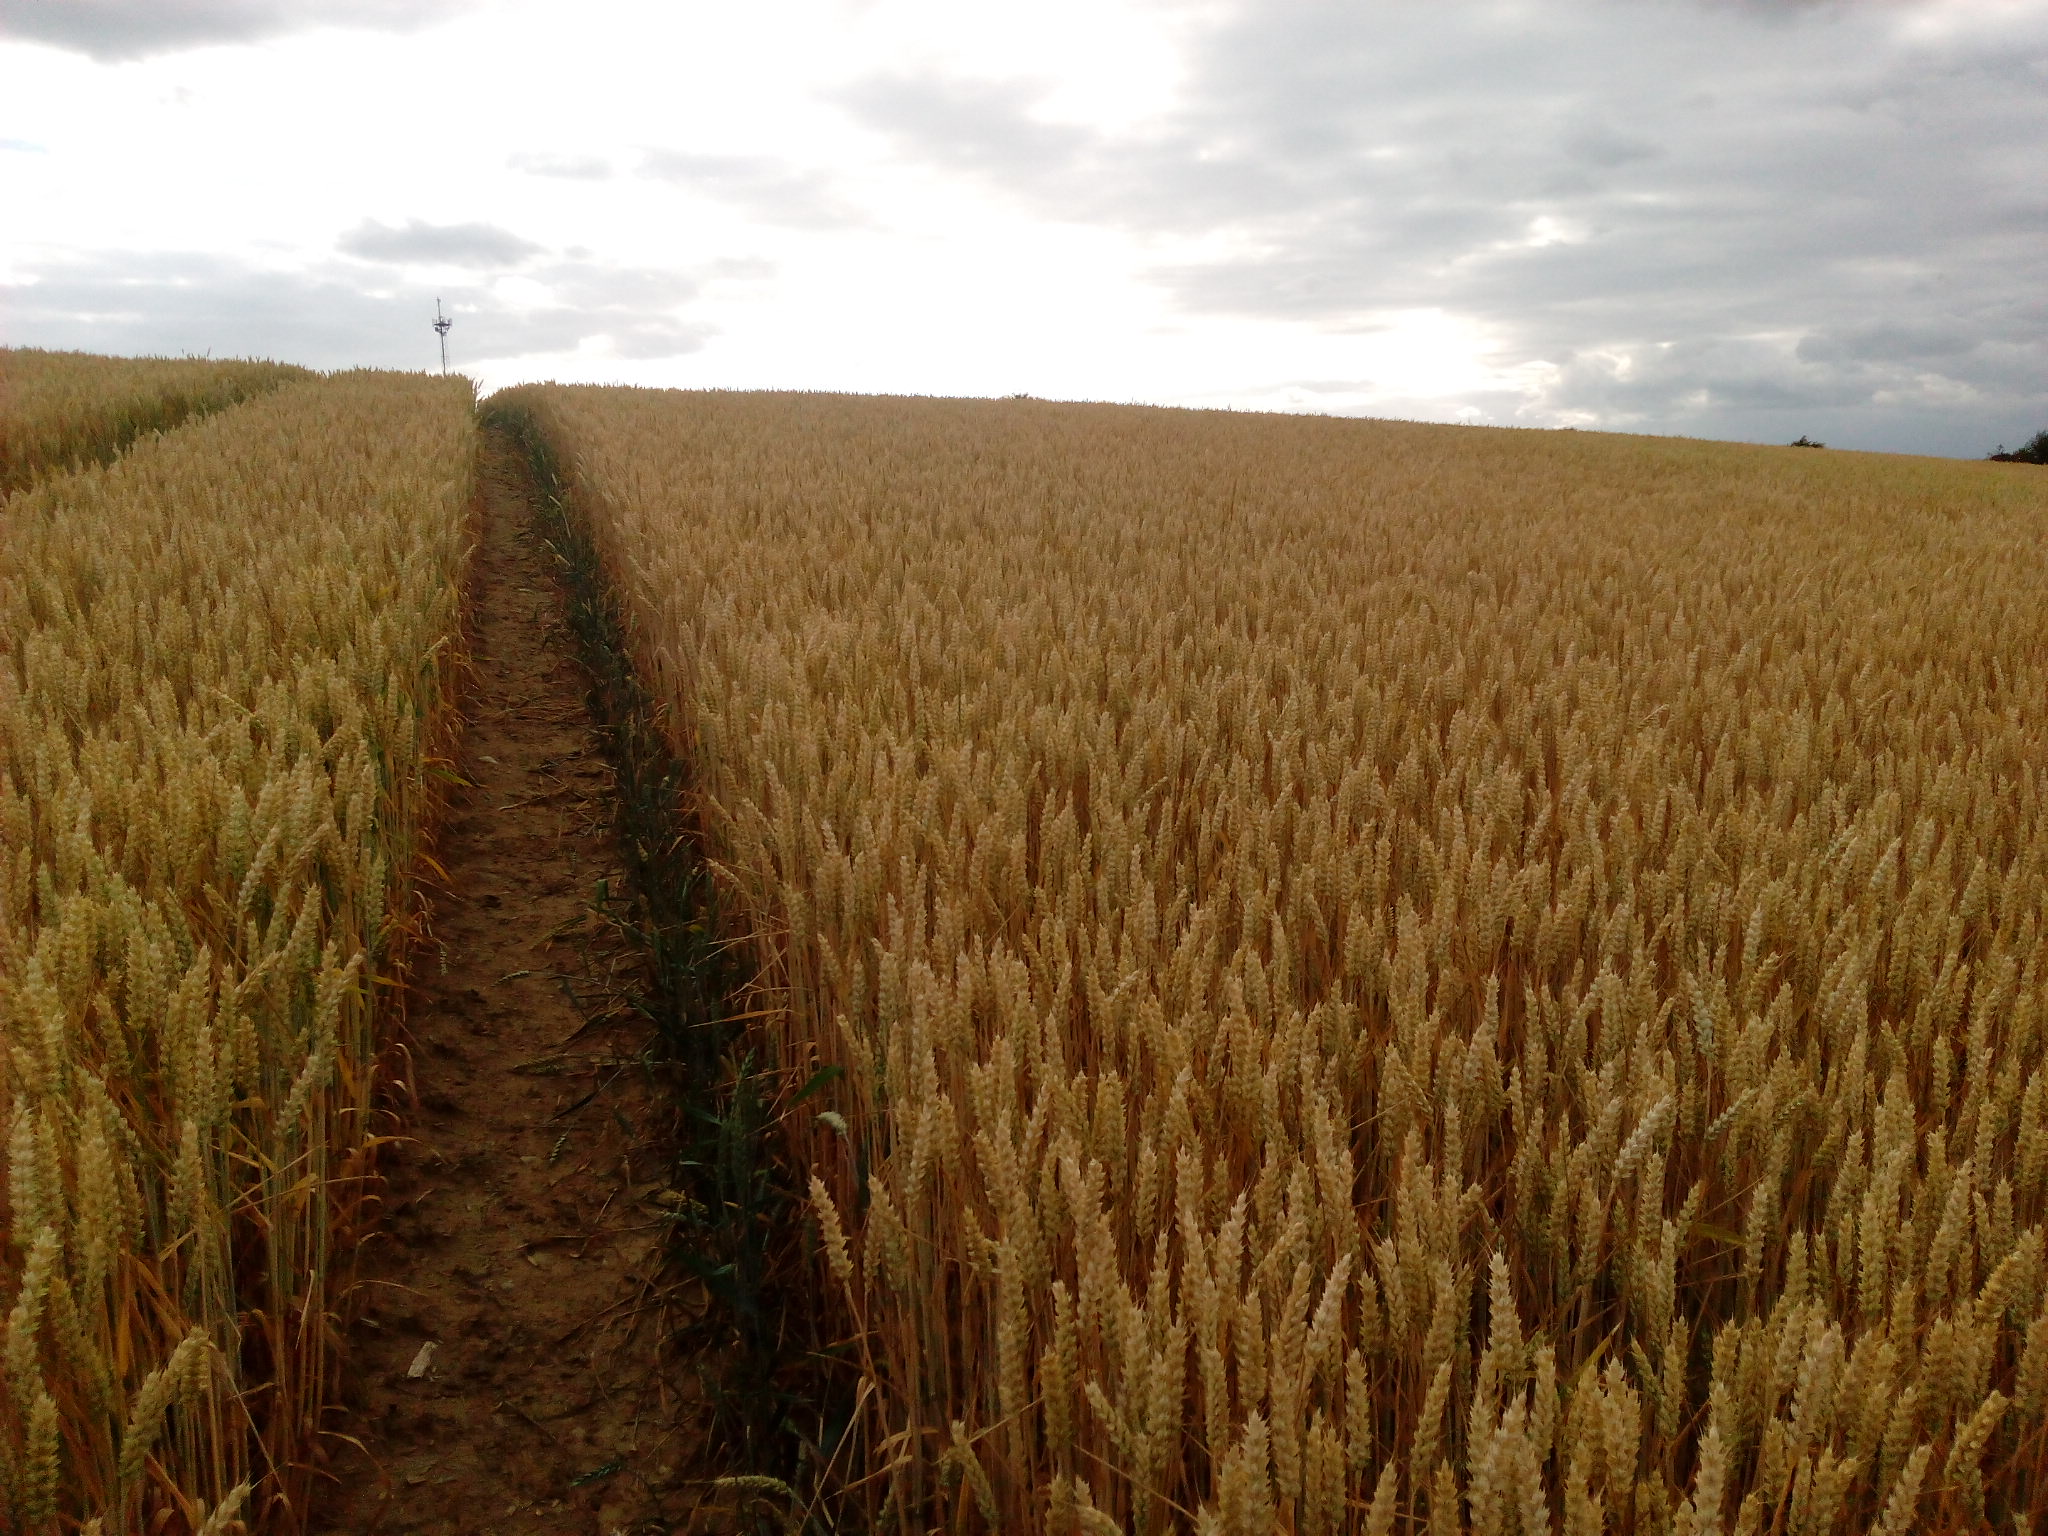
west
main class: Cropland
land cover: Common wheat
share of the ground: > 75 %
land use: Agriculture (excluding fallow land and kitchen gardens)
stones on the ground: < 10 %
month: July
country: DE
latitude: 53.2936
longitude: 14.1864
